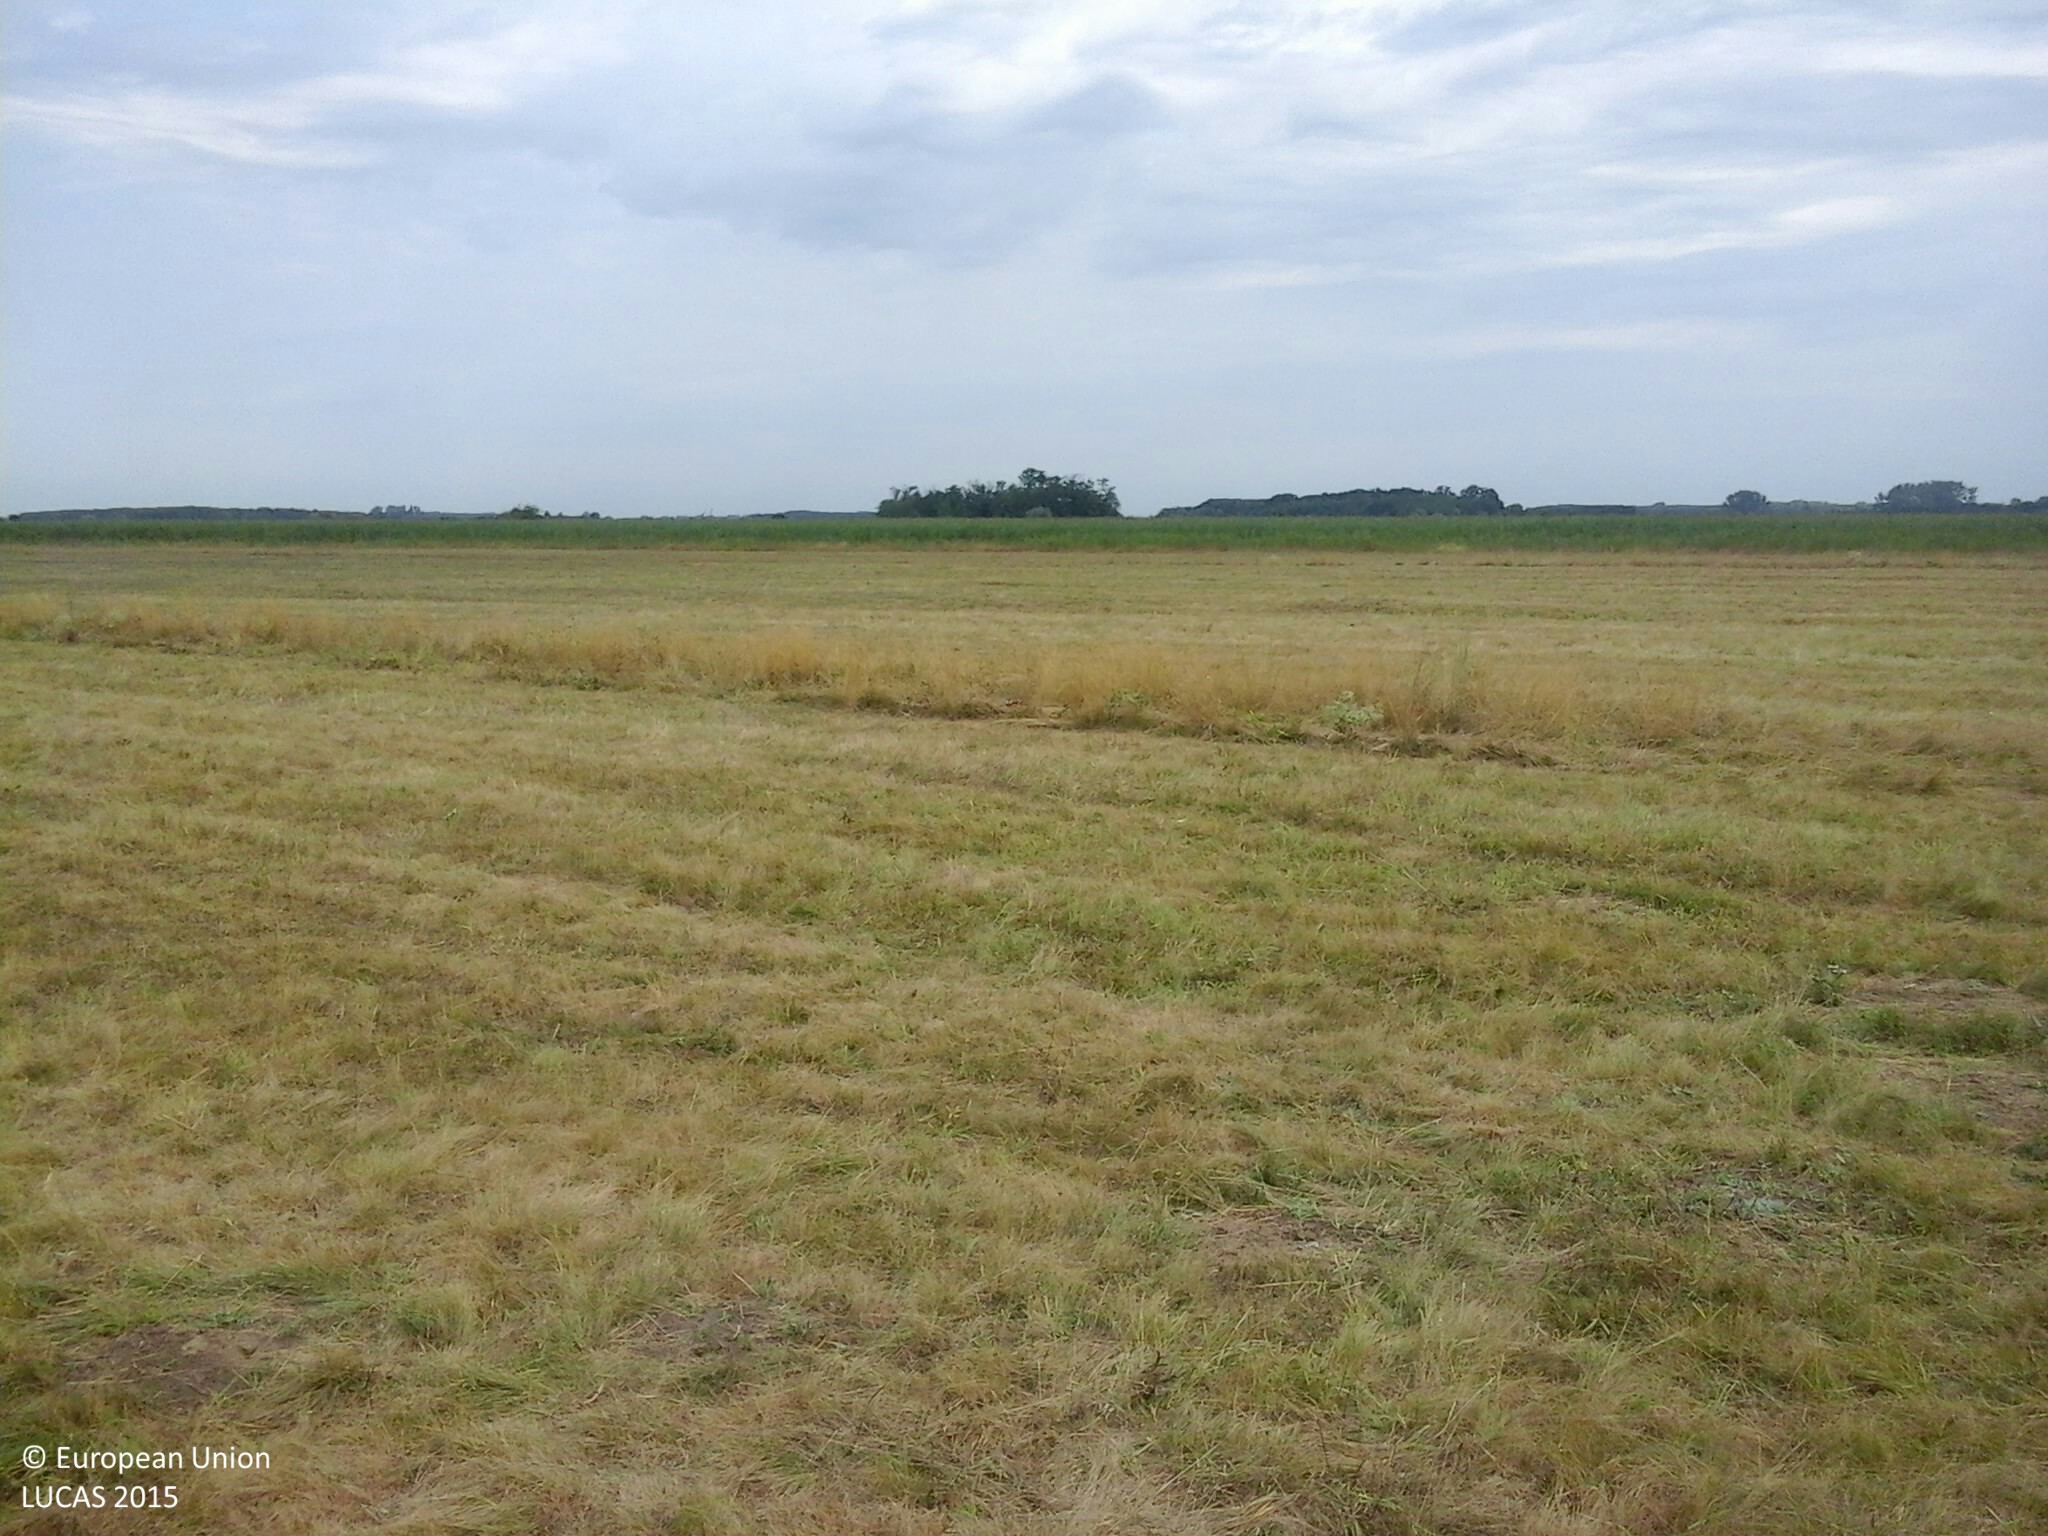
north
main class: Grassland
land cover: Grassland without tree/shrub cover
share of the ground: > 75 %
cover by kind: herbaceous plants 100 %
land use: Agriculture (excluding fallow land and kitchen gardens)
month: July
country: HU
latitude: 46.5276
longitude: 20.0739
